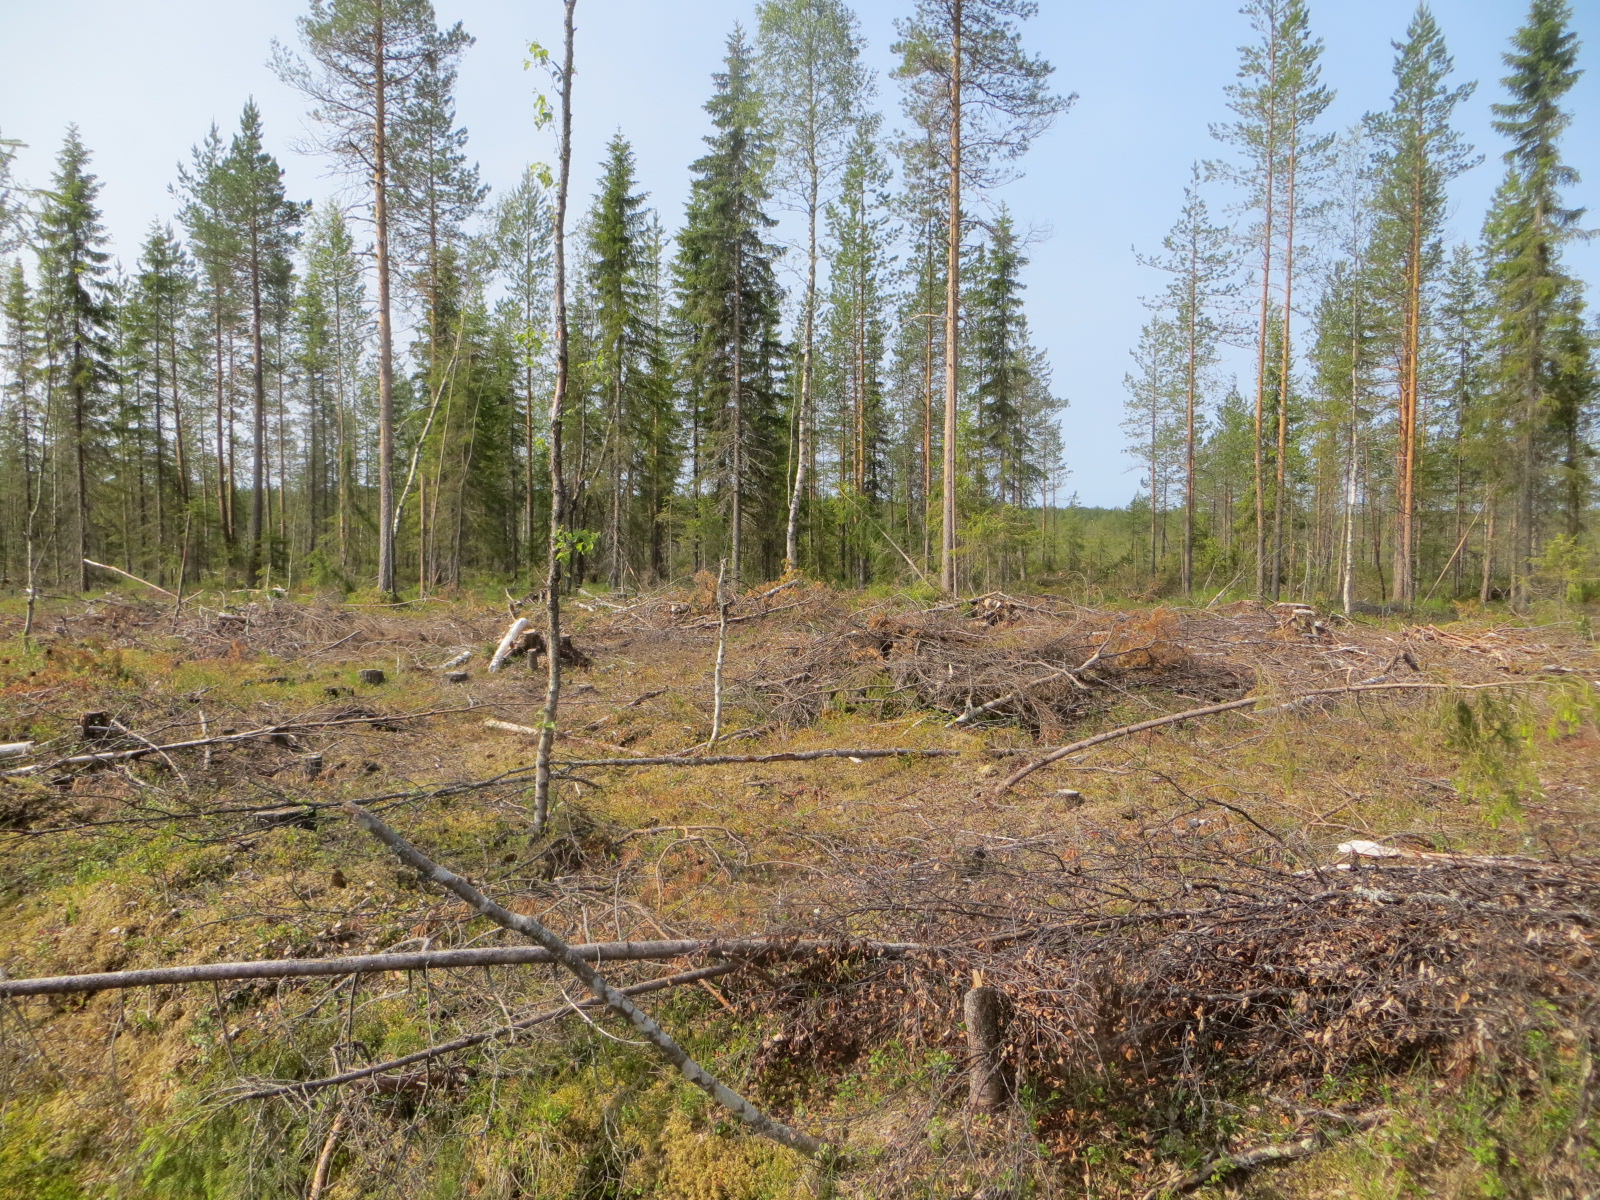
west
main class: Woodland
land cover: Pine dominated mixed woodland
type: boreal forest
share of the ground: 10 - 25 %
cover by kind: shrubs 45 %, lichens and mosses 45 %, coniferous forest trees 5 %, broadleaved forest trees 5 %
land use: Forestry
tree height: > 5 m
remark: Clear cut
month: July
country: FI
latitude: 65.8583
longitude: 25.6106
